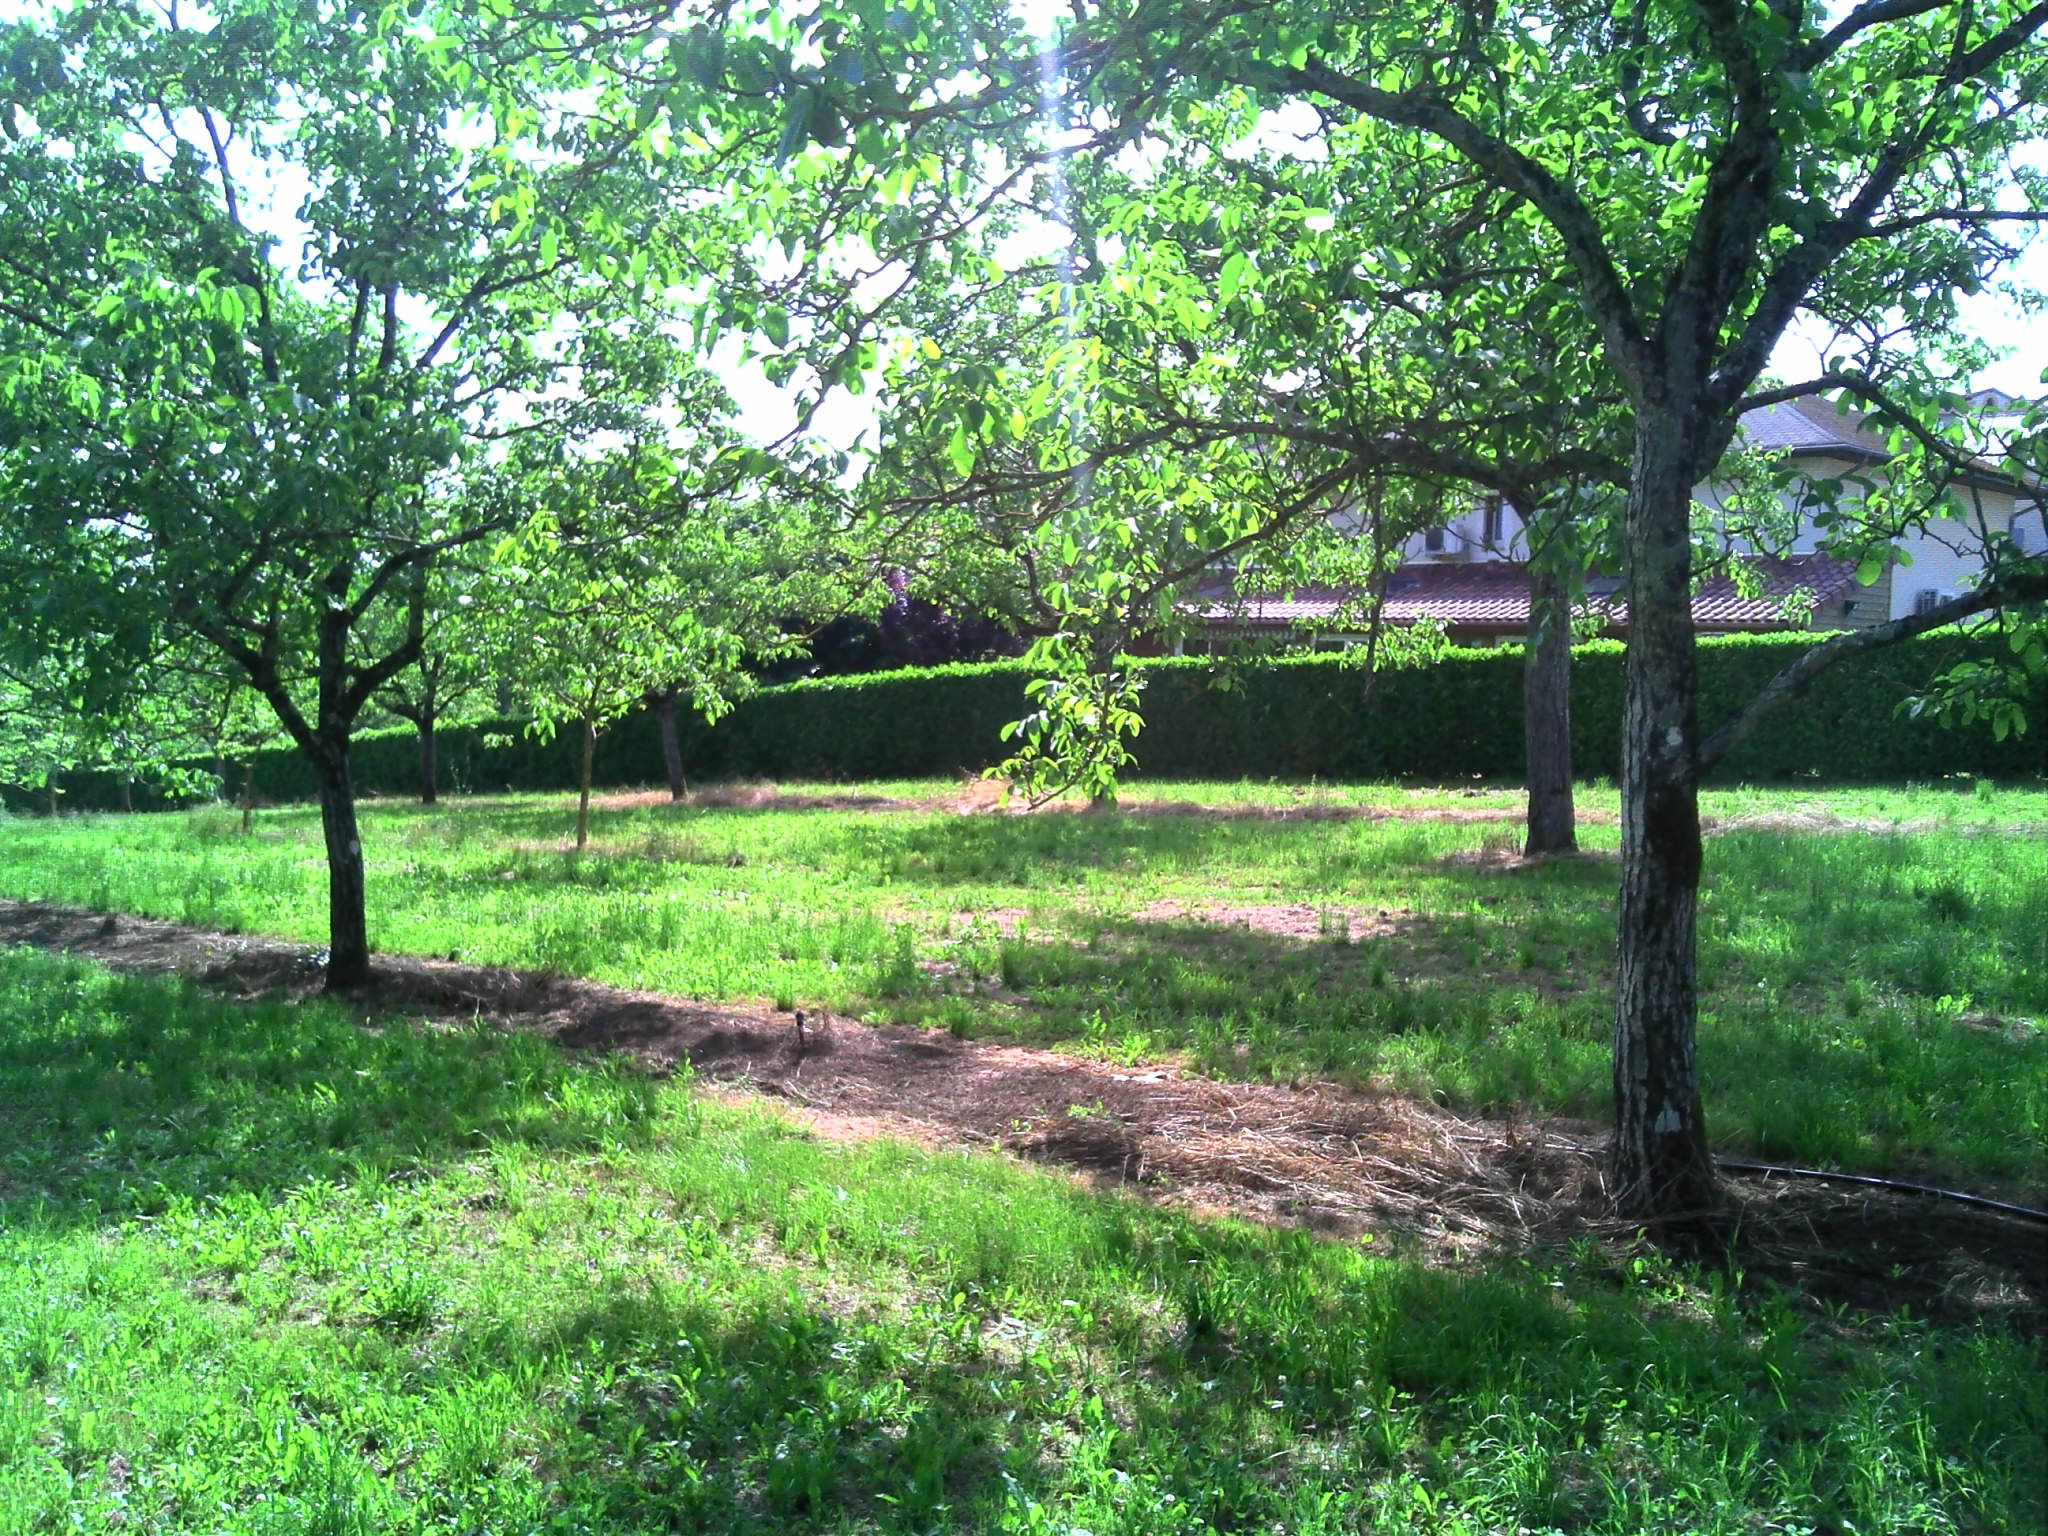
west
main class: Cropland
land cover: Nuts trees
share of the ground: > 75 %
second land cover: Grassland without tree/shrub cover
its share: 10 - 25 %
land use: Agriculture (excluding fallow land and kitchen gardens)
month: June
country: FR
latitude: 44.9195
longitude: 1.8778
